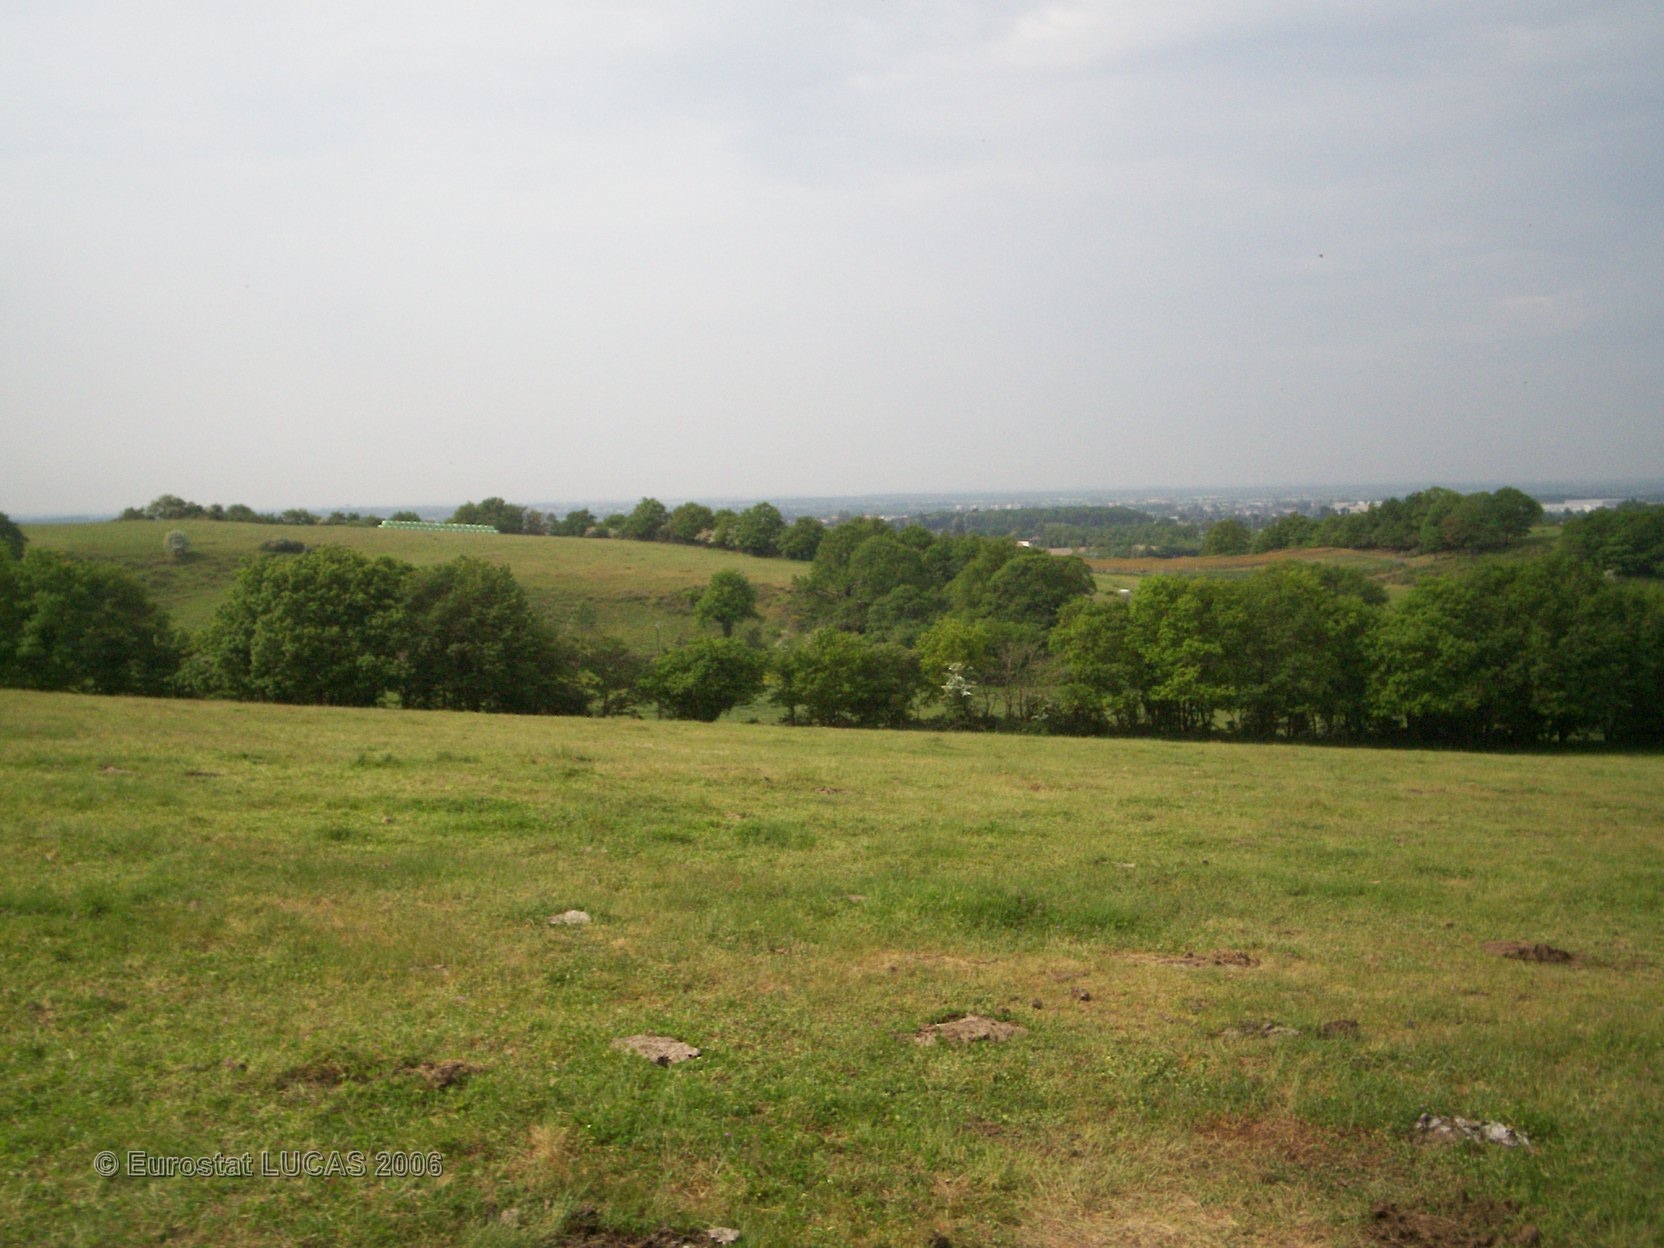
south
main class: Grassland
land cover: Grassland without tree/shrub cover
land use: Agriculture (excluding fallow land and kitchen gardens)
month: May
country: FR
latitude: 46.8911
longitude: -0.9927
